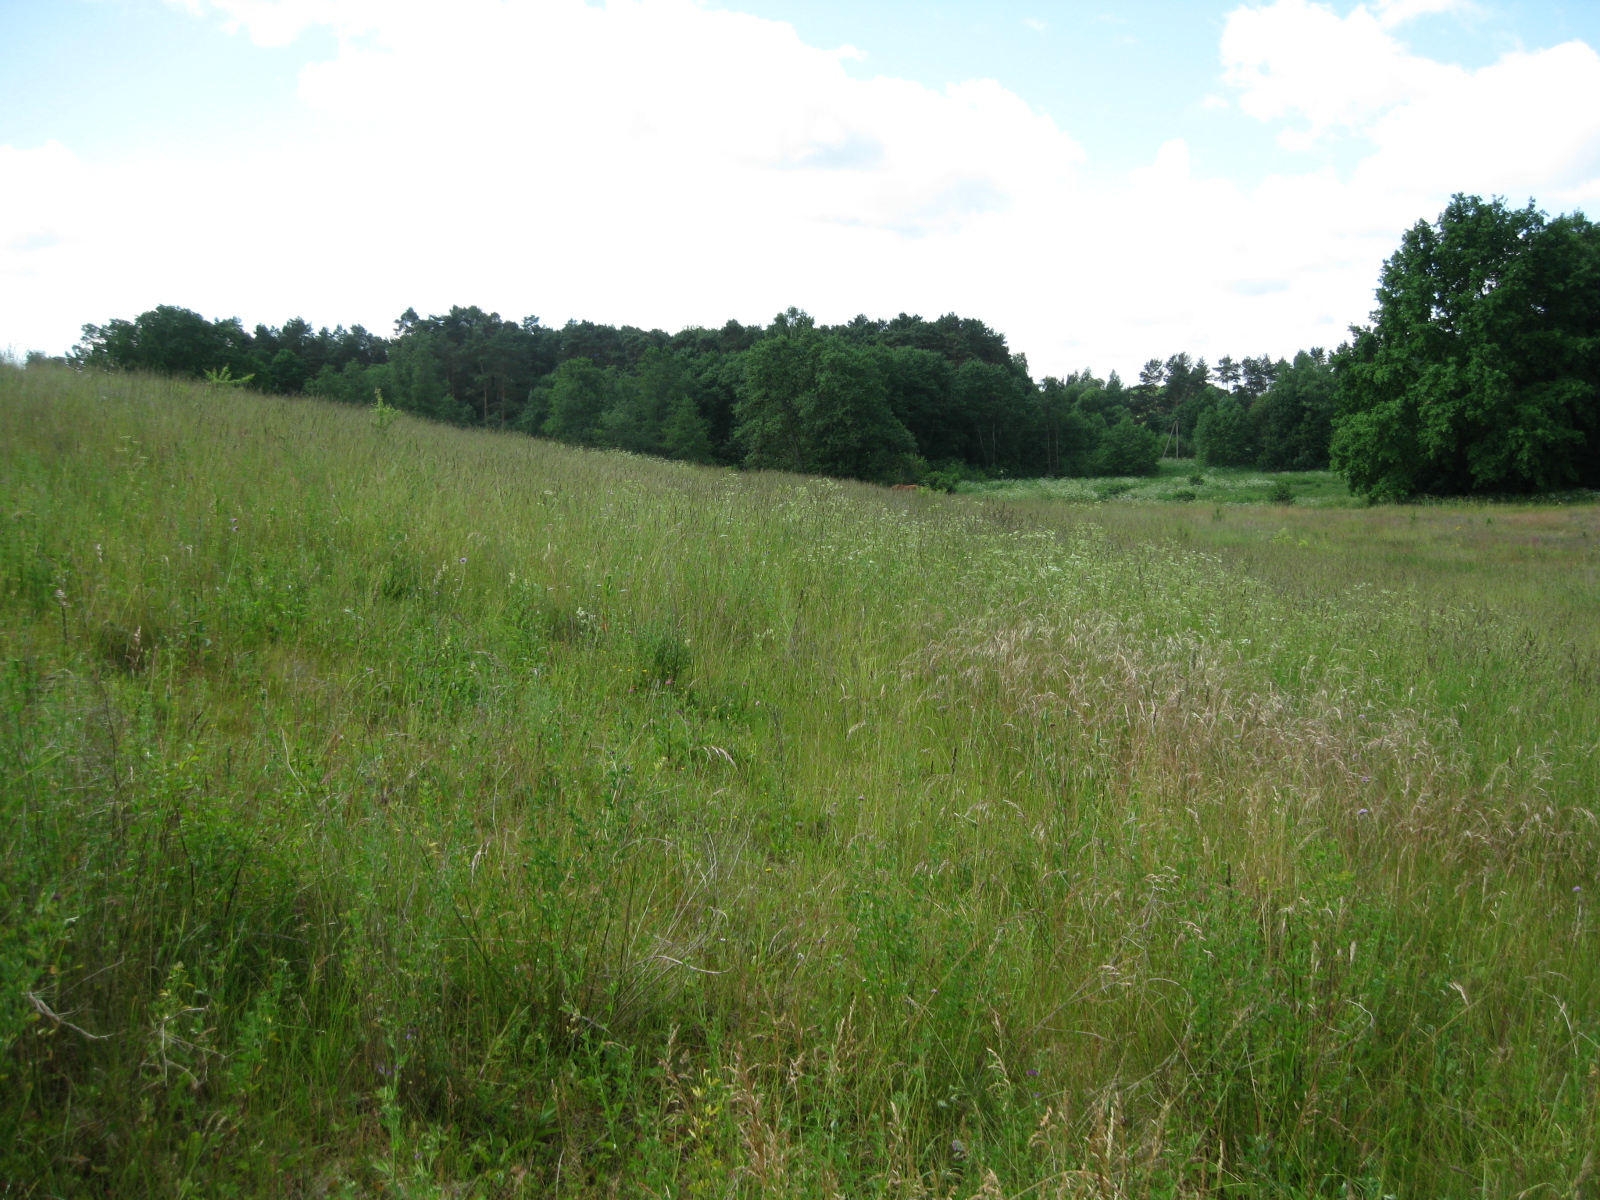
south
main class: Grassland
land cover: Grassland with sparse tree/shrub cover
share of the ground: > 75 %
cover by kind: herbaceous plants 90 %, broadleaved forest trees 5 %, shrubs 5 %
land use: Agriculture (excluding fallow land and kitchen gardens)
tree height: < 5 m
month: June
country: LT
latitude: 55.5655
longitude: 24.1251
